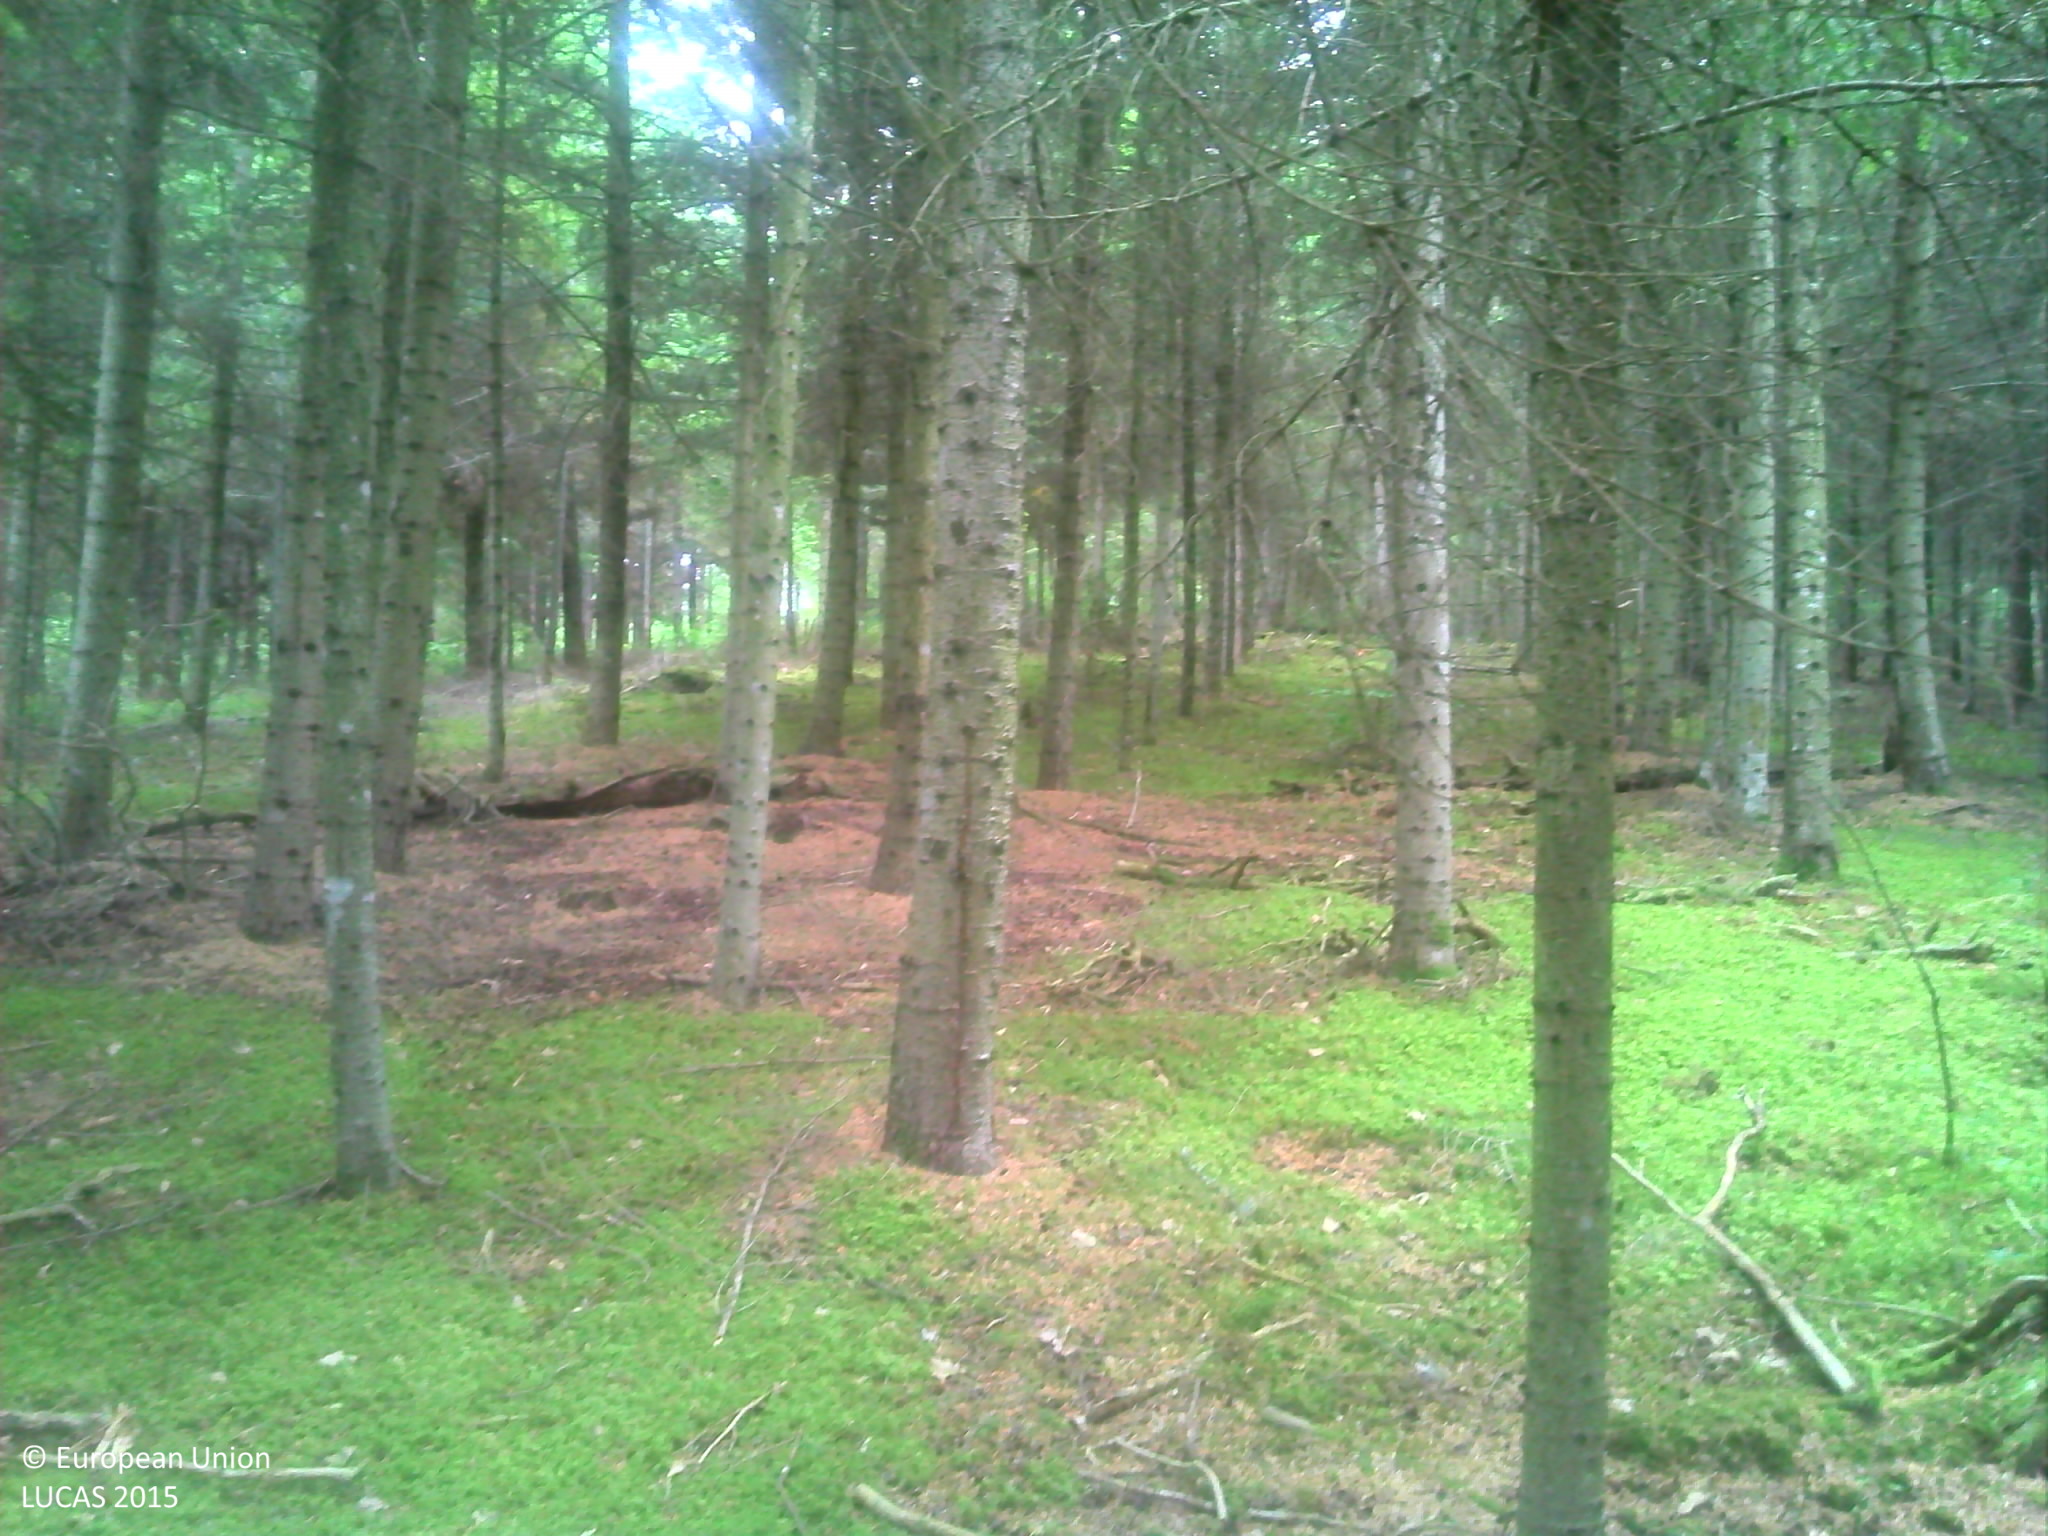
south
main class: Woodland
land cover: Spruce dominated coniferous woodland
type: exotic forest
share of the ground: > 75 %
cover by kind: coniferous forest trees 80 %, lichens and mosses 10 %, herbaceous plants 5 %, unconsolidated bare surface 5 %
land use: Forestry
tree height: > 5 m
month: July
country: FR
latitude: 45.1630
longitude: 3.8590
